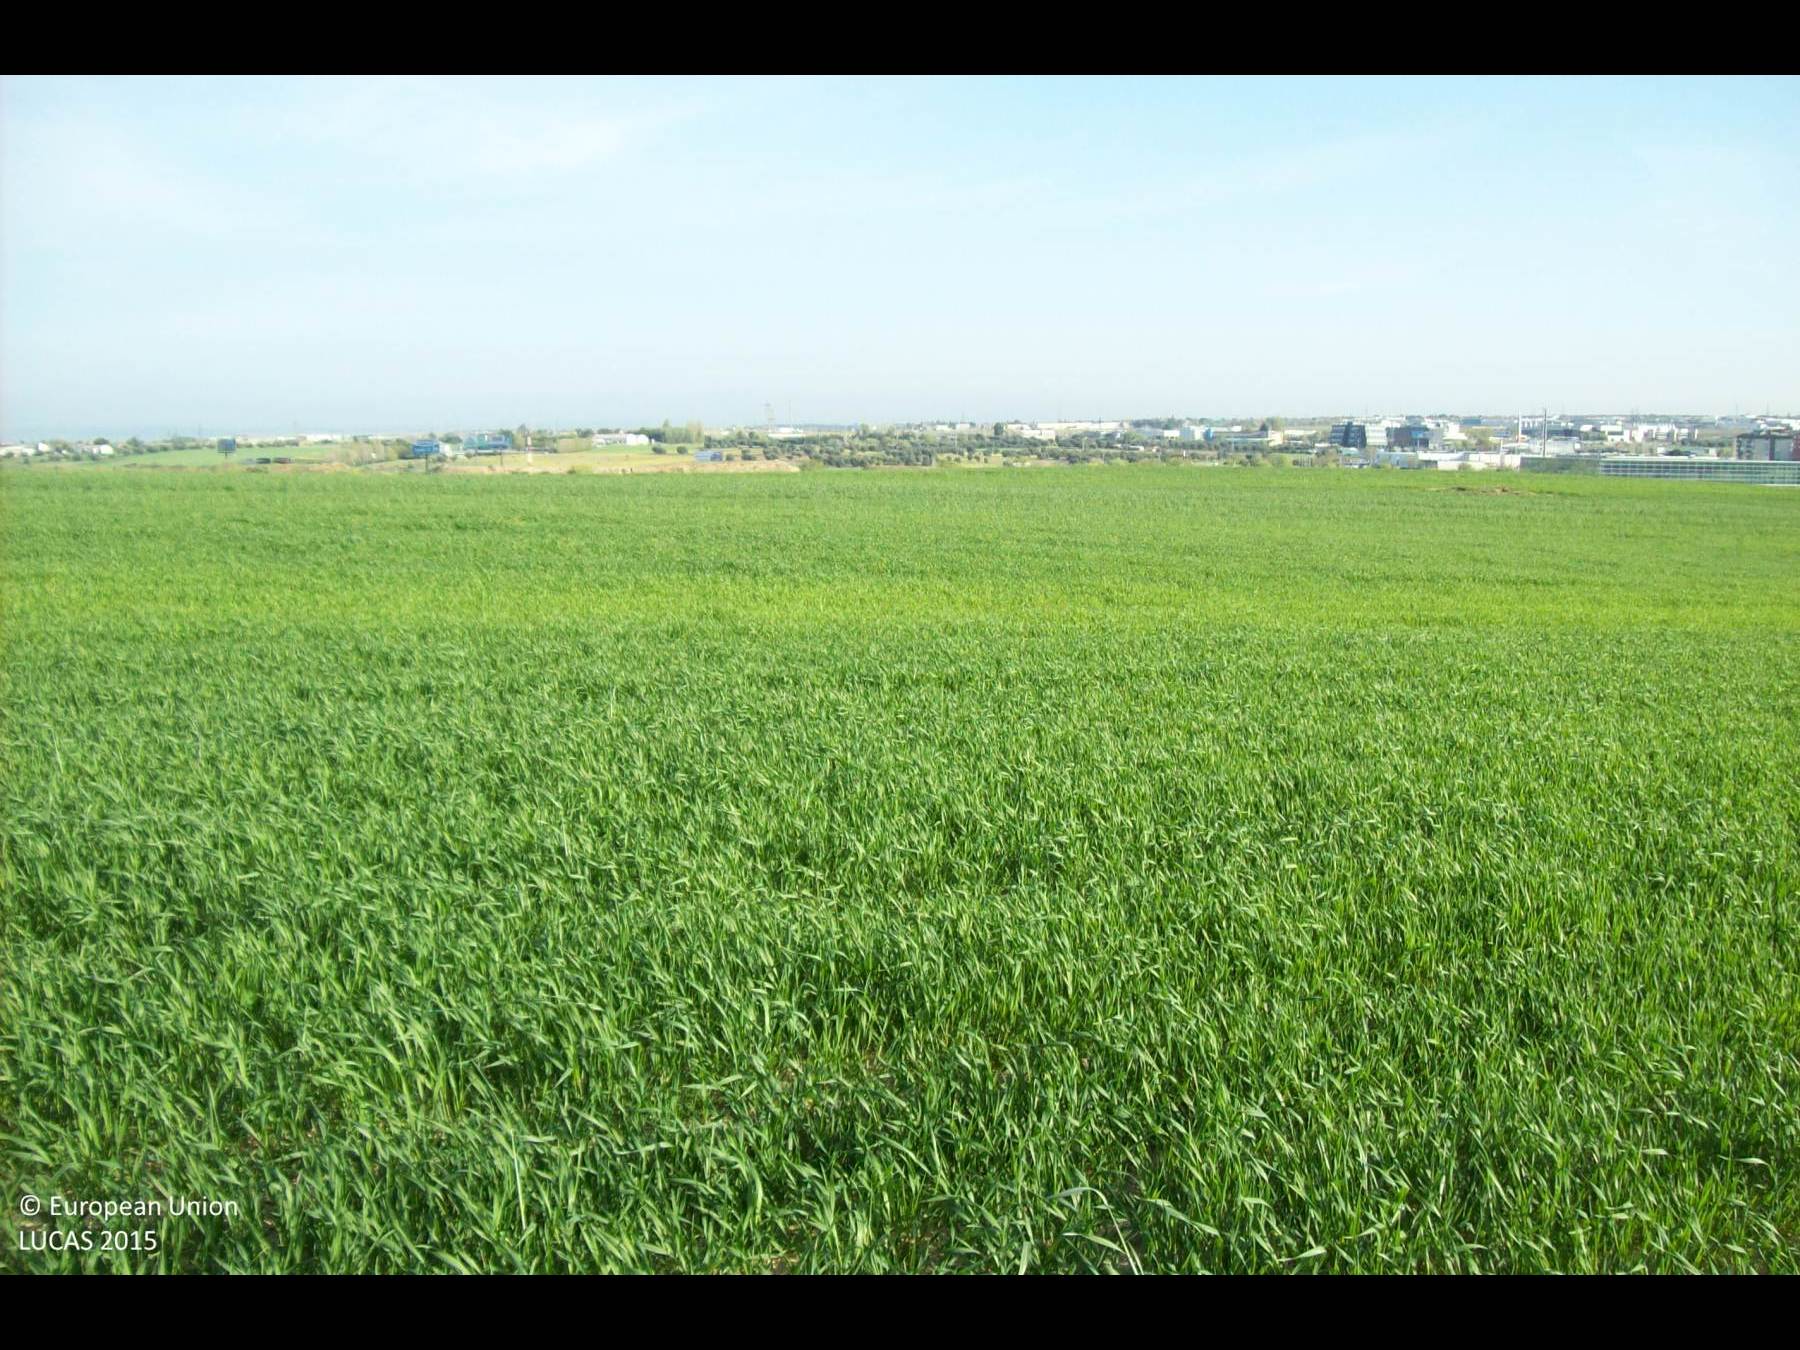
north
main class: Cropland
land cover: Barley
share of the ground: > 75 %
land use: Agriculture (excluding fallow land and kitchen gardens)
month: April
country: ES
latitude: 40.3186
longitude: -3.8899
